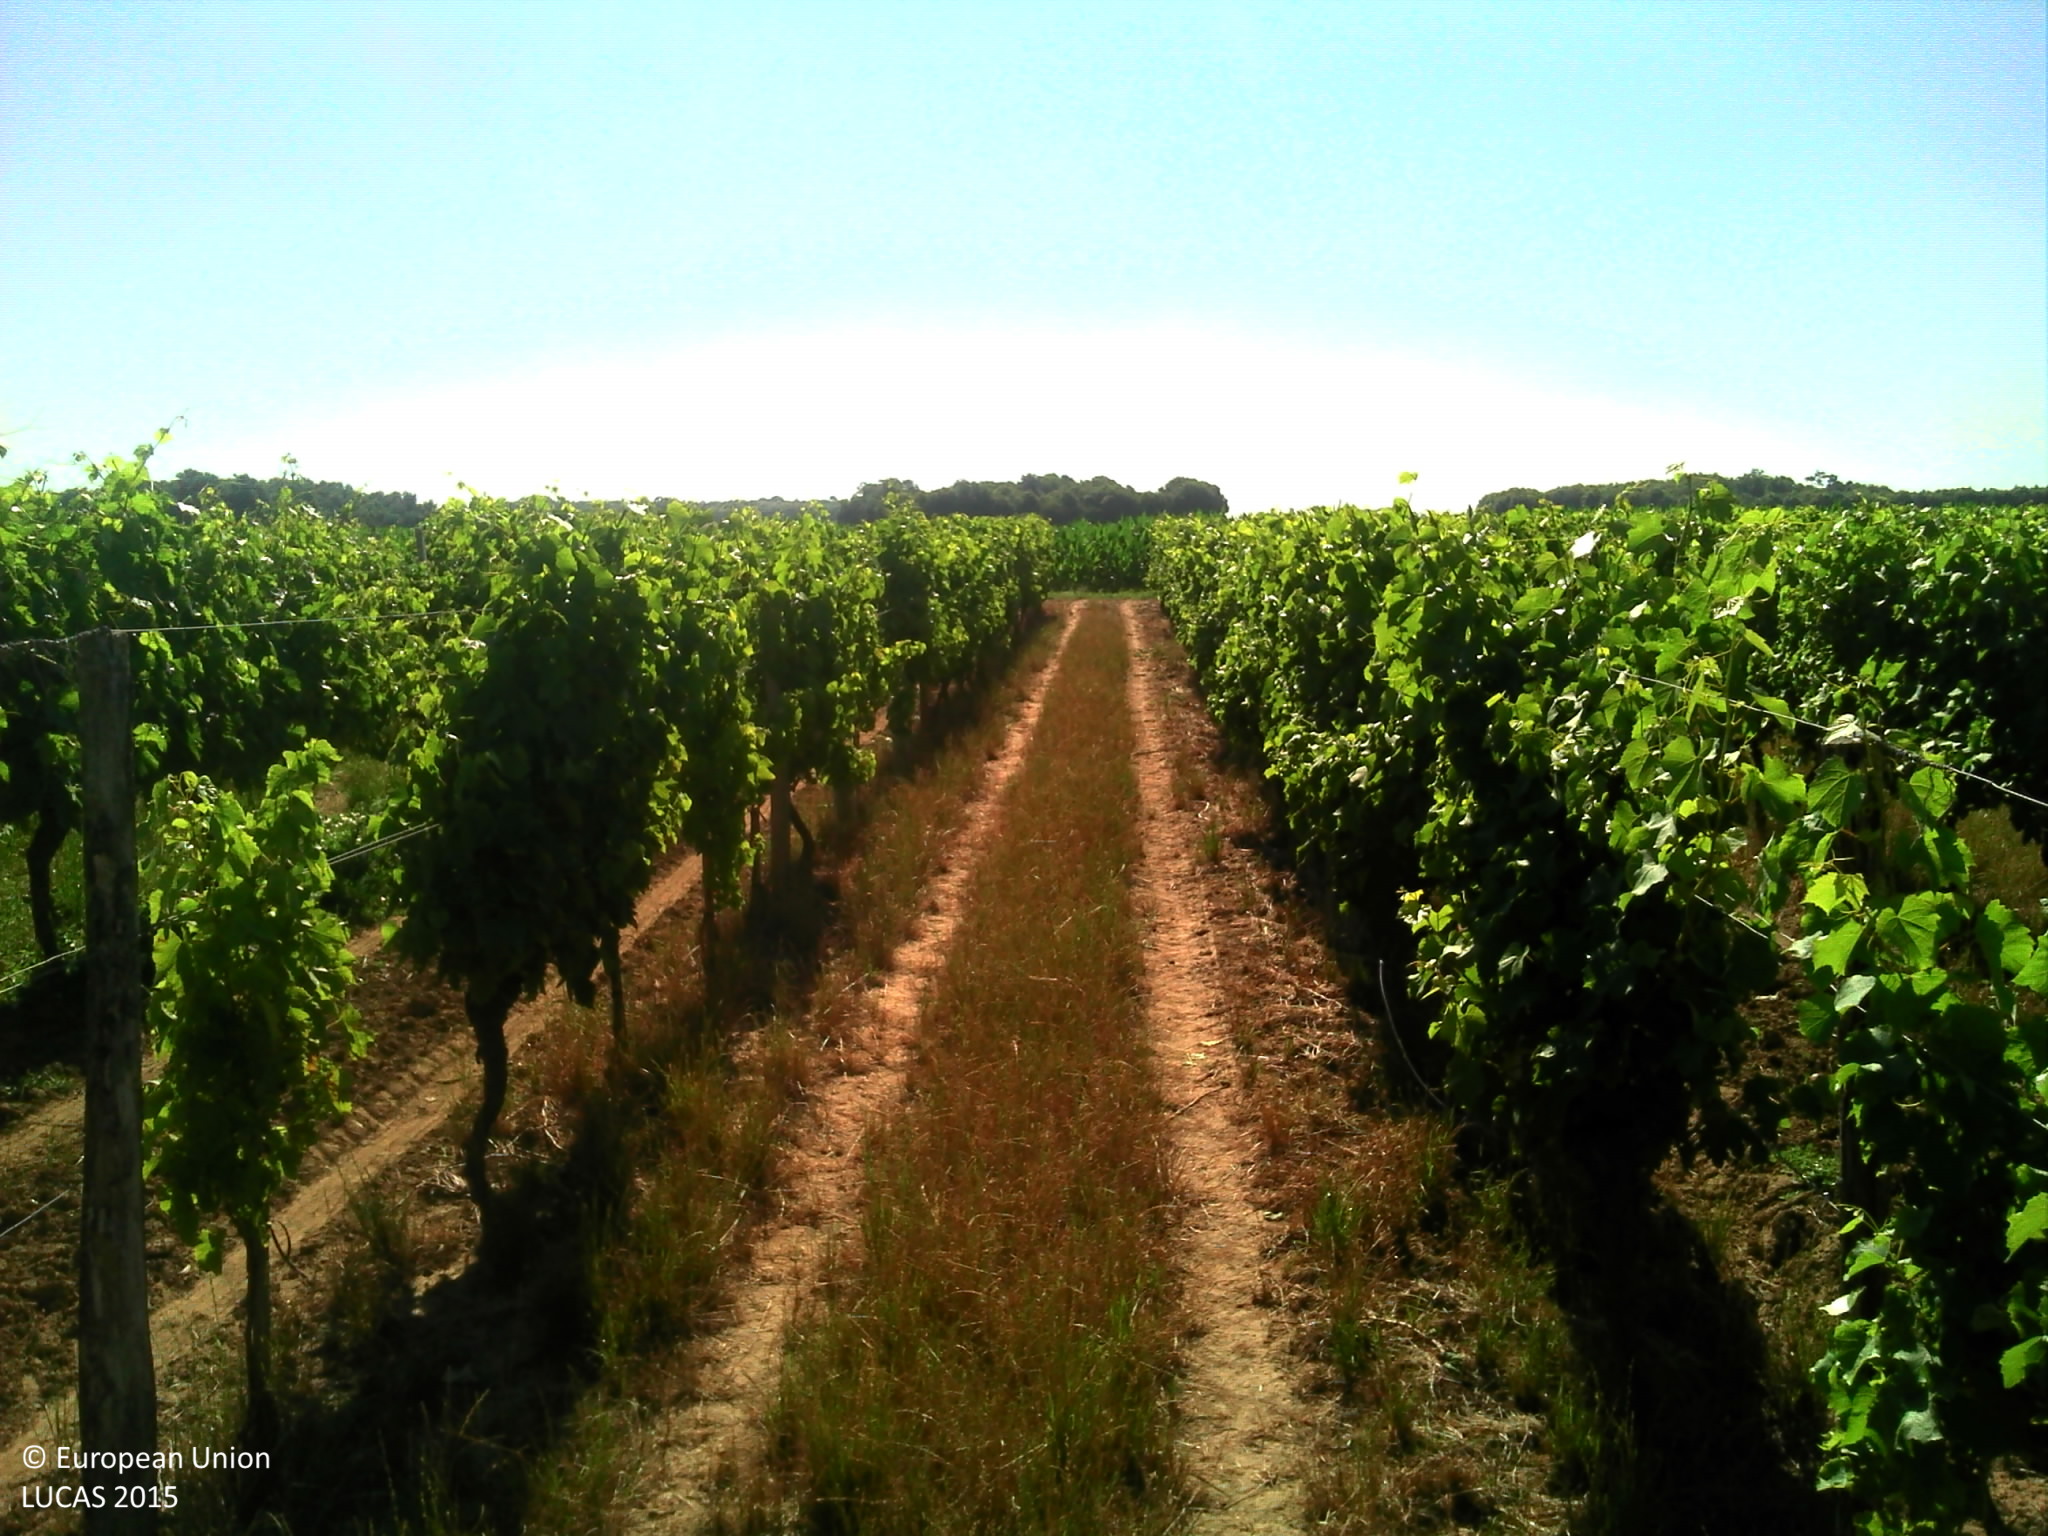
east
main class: Cropland
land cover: Vineyards
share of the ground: 25 - 50 %
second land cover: Grassland without tree/shrub cover
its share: 50 - 75 %
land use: Agriculture (excluding fallow land and kitchen gardens)
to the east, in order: Vineyards; Grassland without tree/shrub cover; Maize; Durum wheat
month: June
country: FR
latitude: 45.6733
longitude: -0.8217
